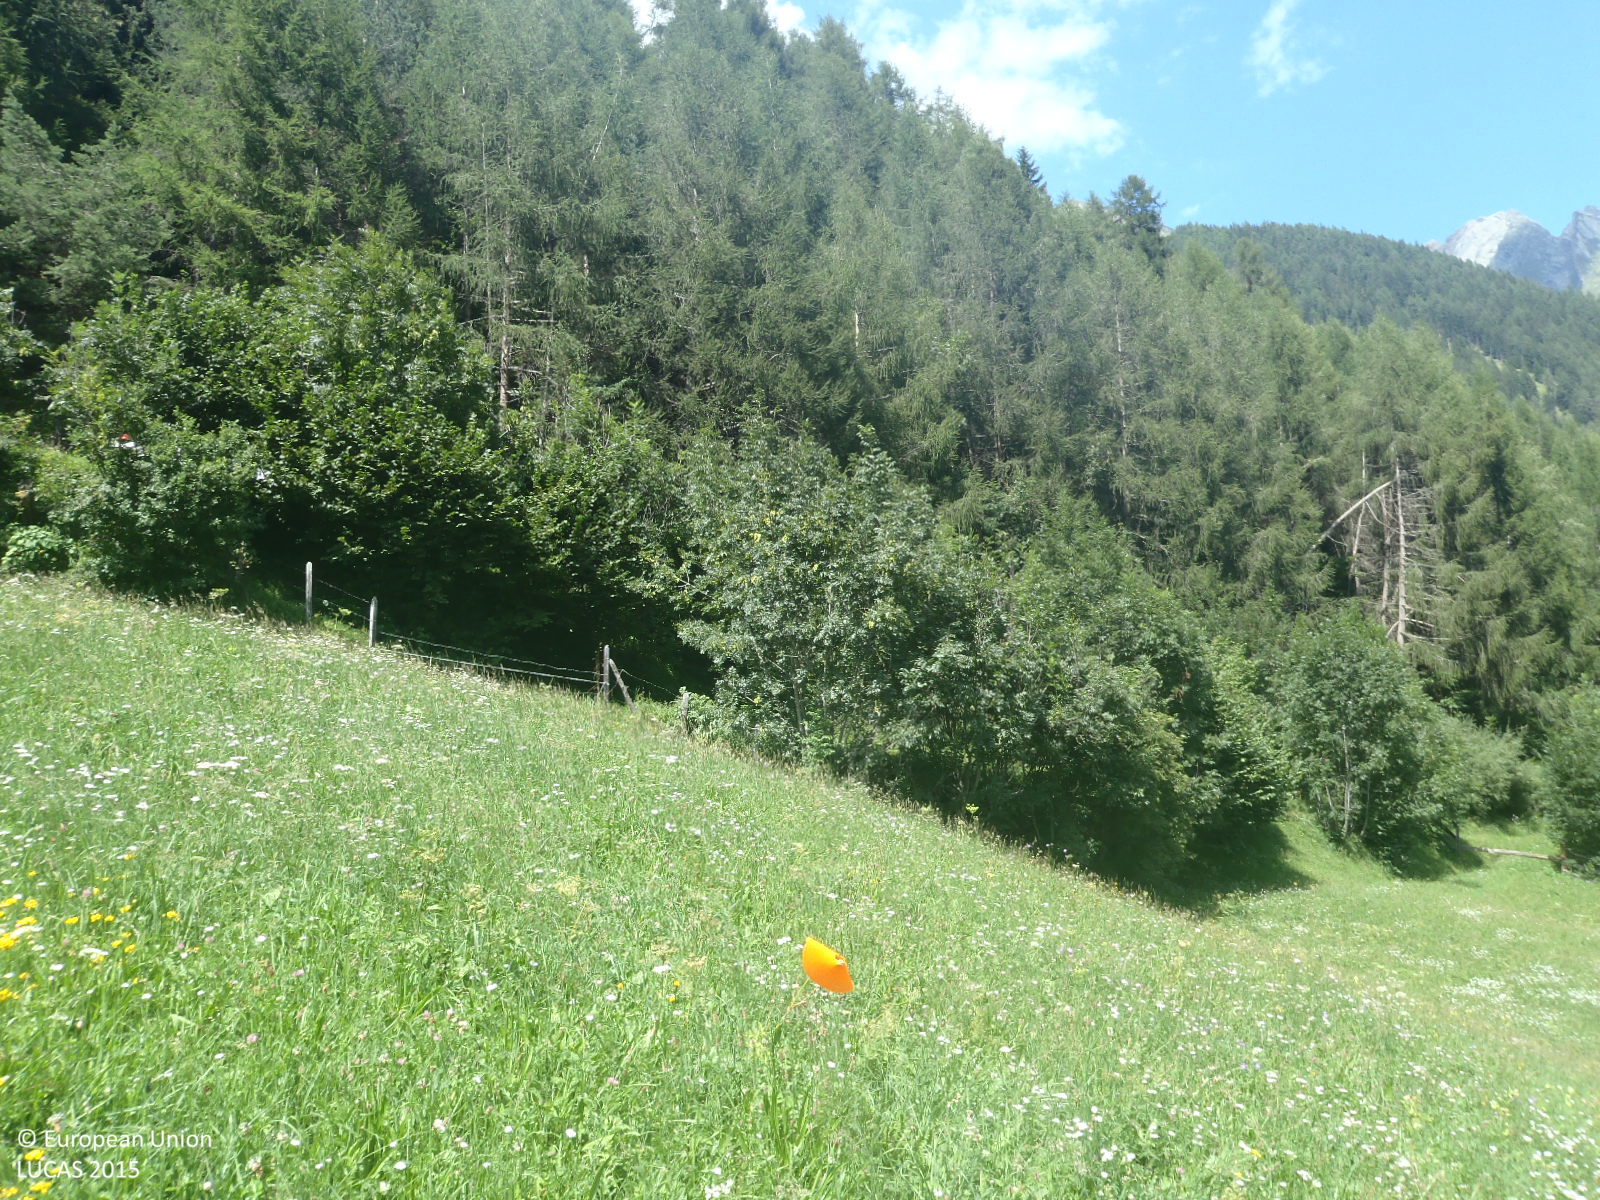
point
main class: Grassland
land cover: Grassland without tree/shrub cover
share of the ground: > 75 %
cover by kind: herbaceous plants 100 %
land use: Agriculture (excluding fallow land and kitchen gardens)
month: August
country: AT
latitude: 47.0082
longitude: 12.4312
